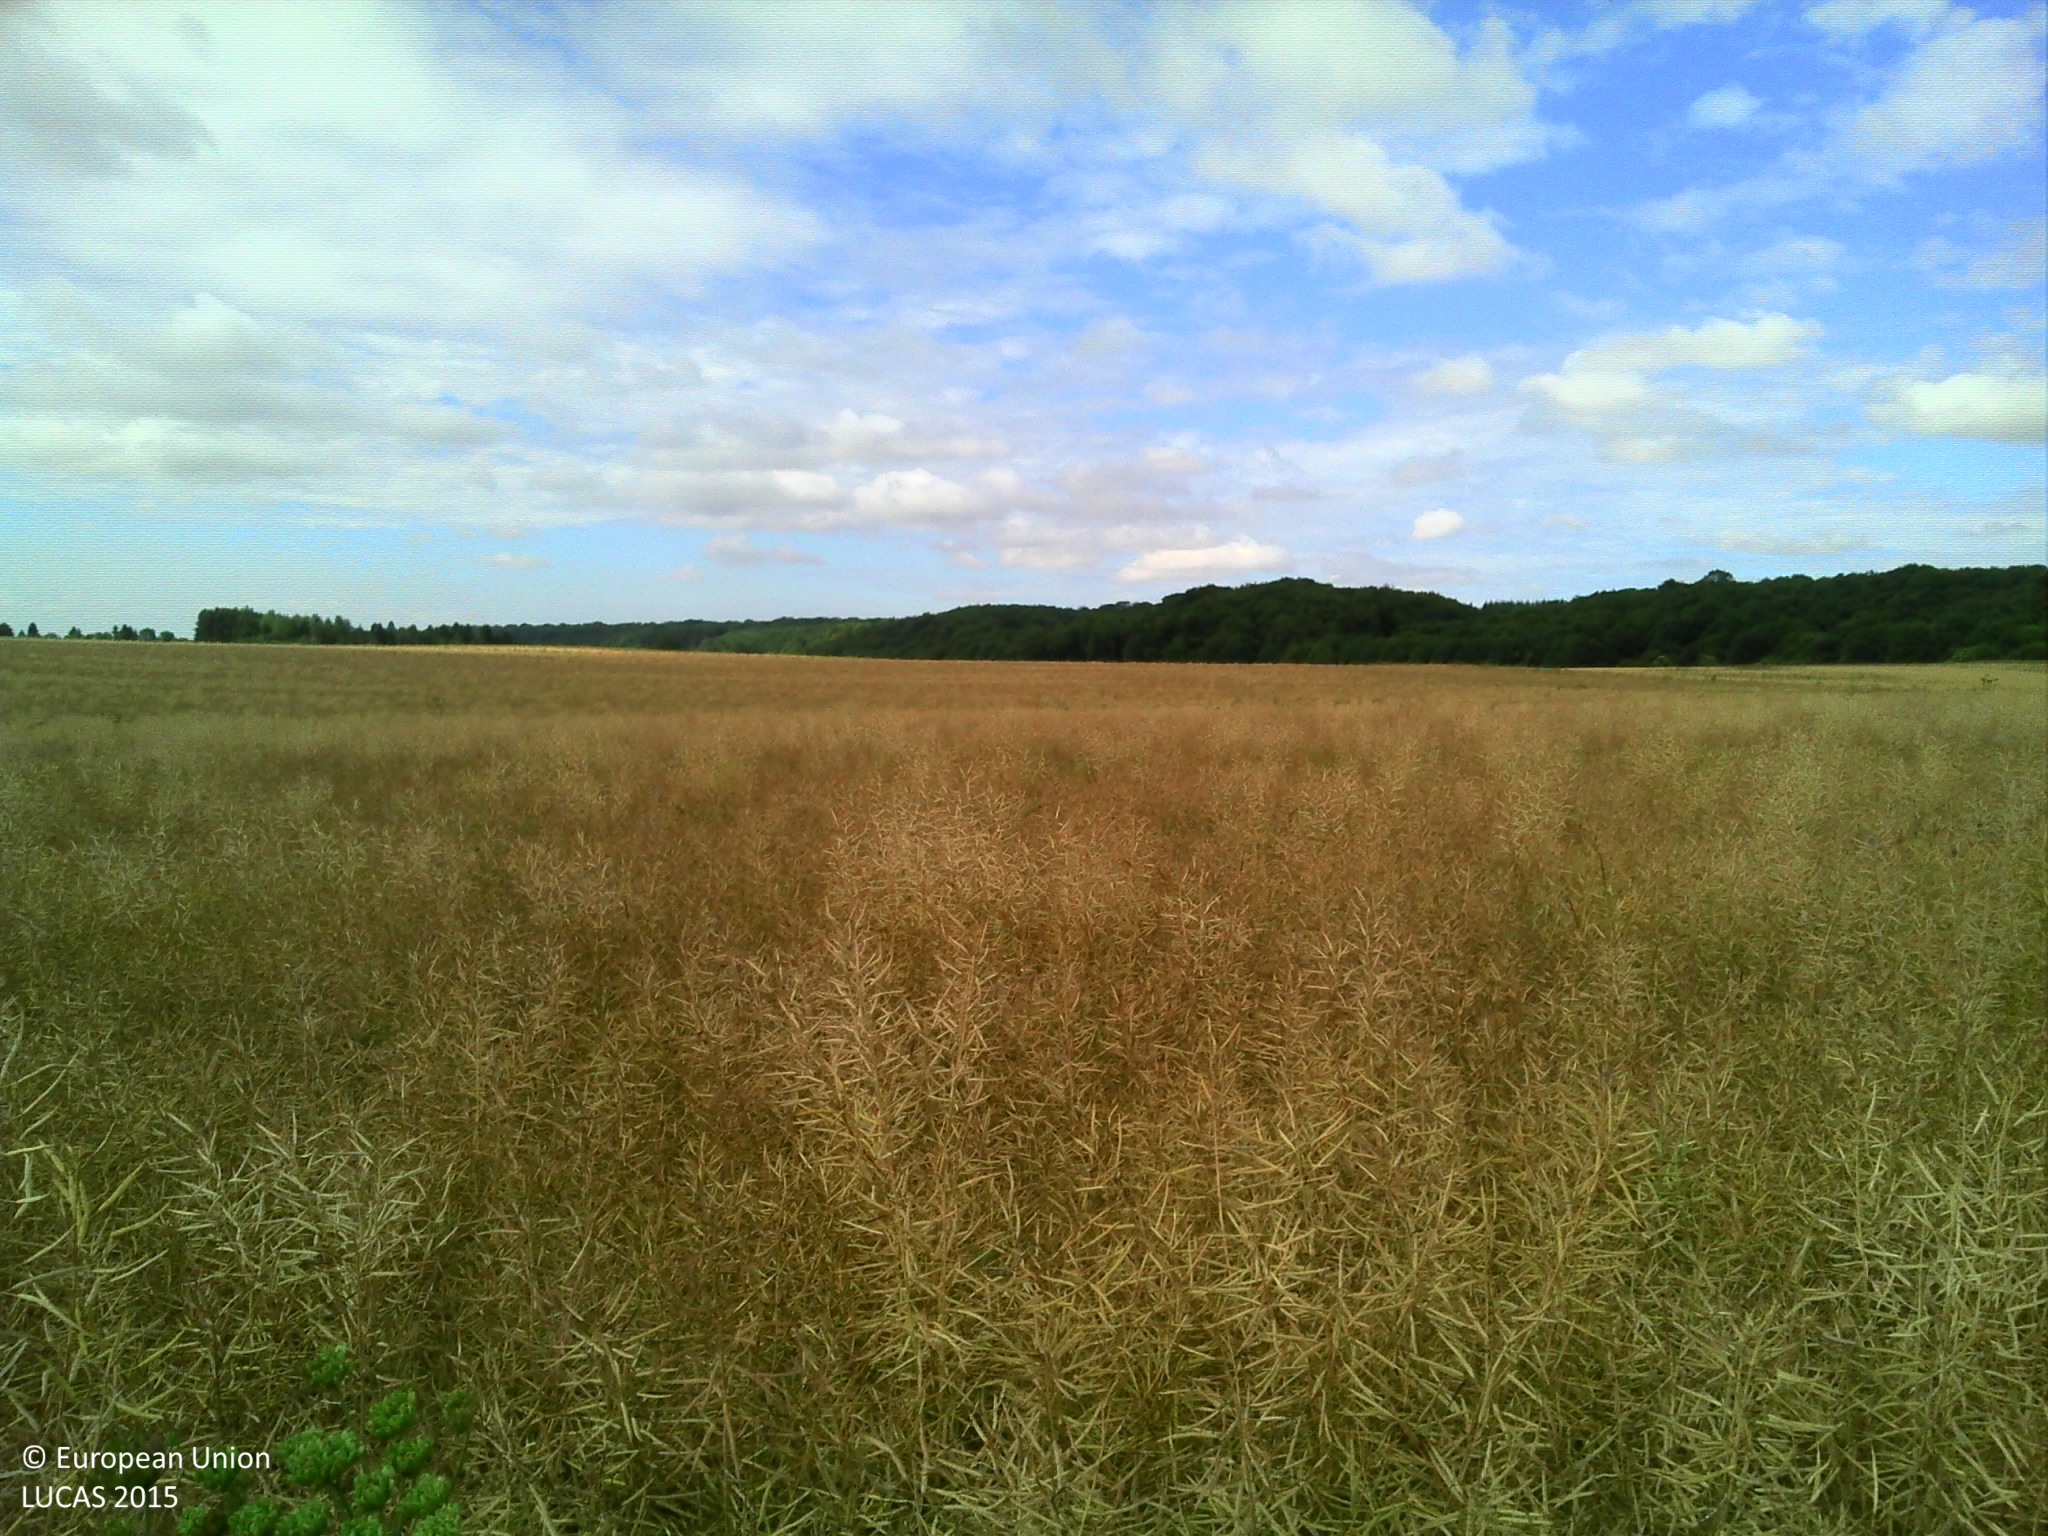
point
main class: Cropland
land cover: Rape and turnip rape
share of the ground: > 75 %
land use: Agriculture (excluding fallow land and kitchen gardens)
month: July
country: FR
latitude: 49.4454
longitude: 5.9304
